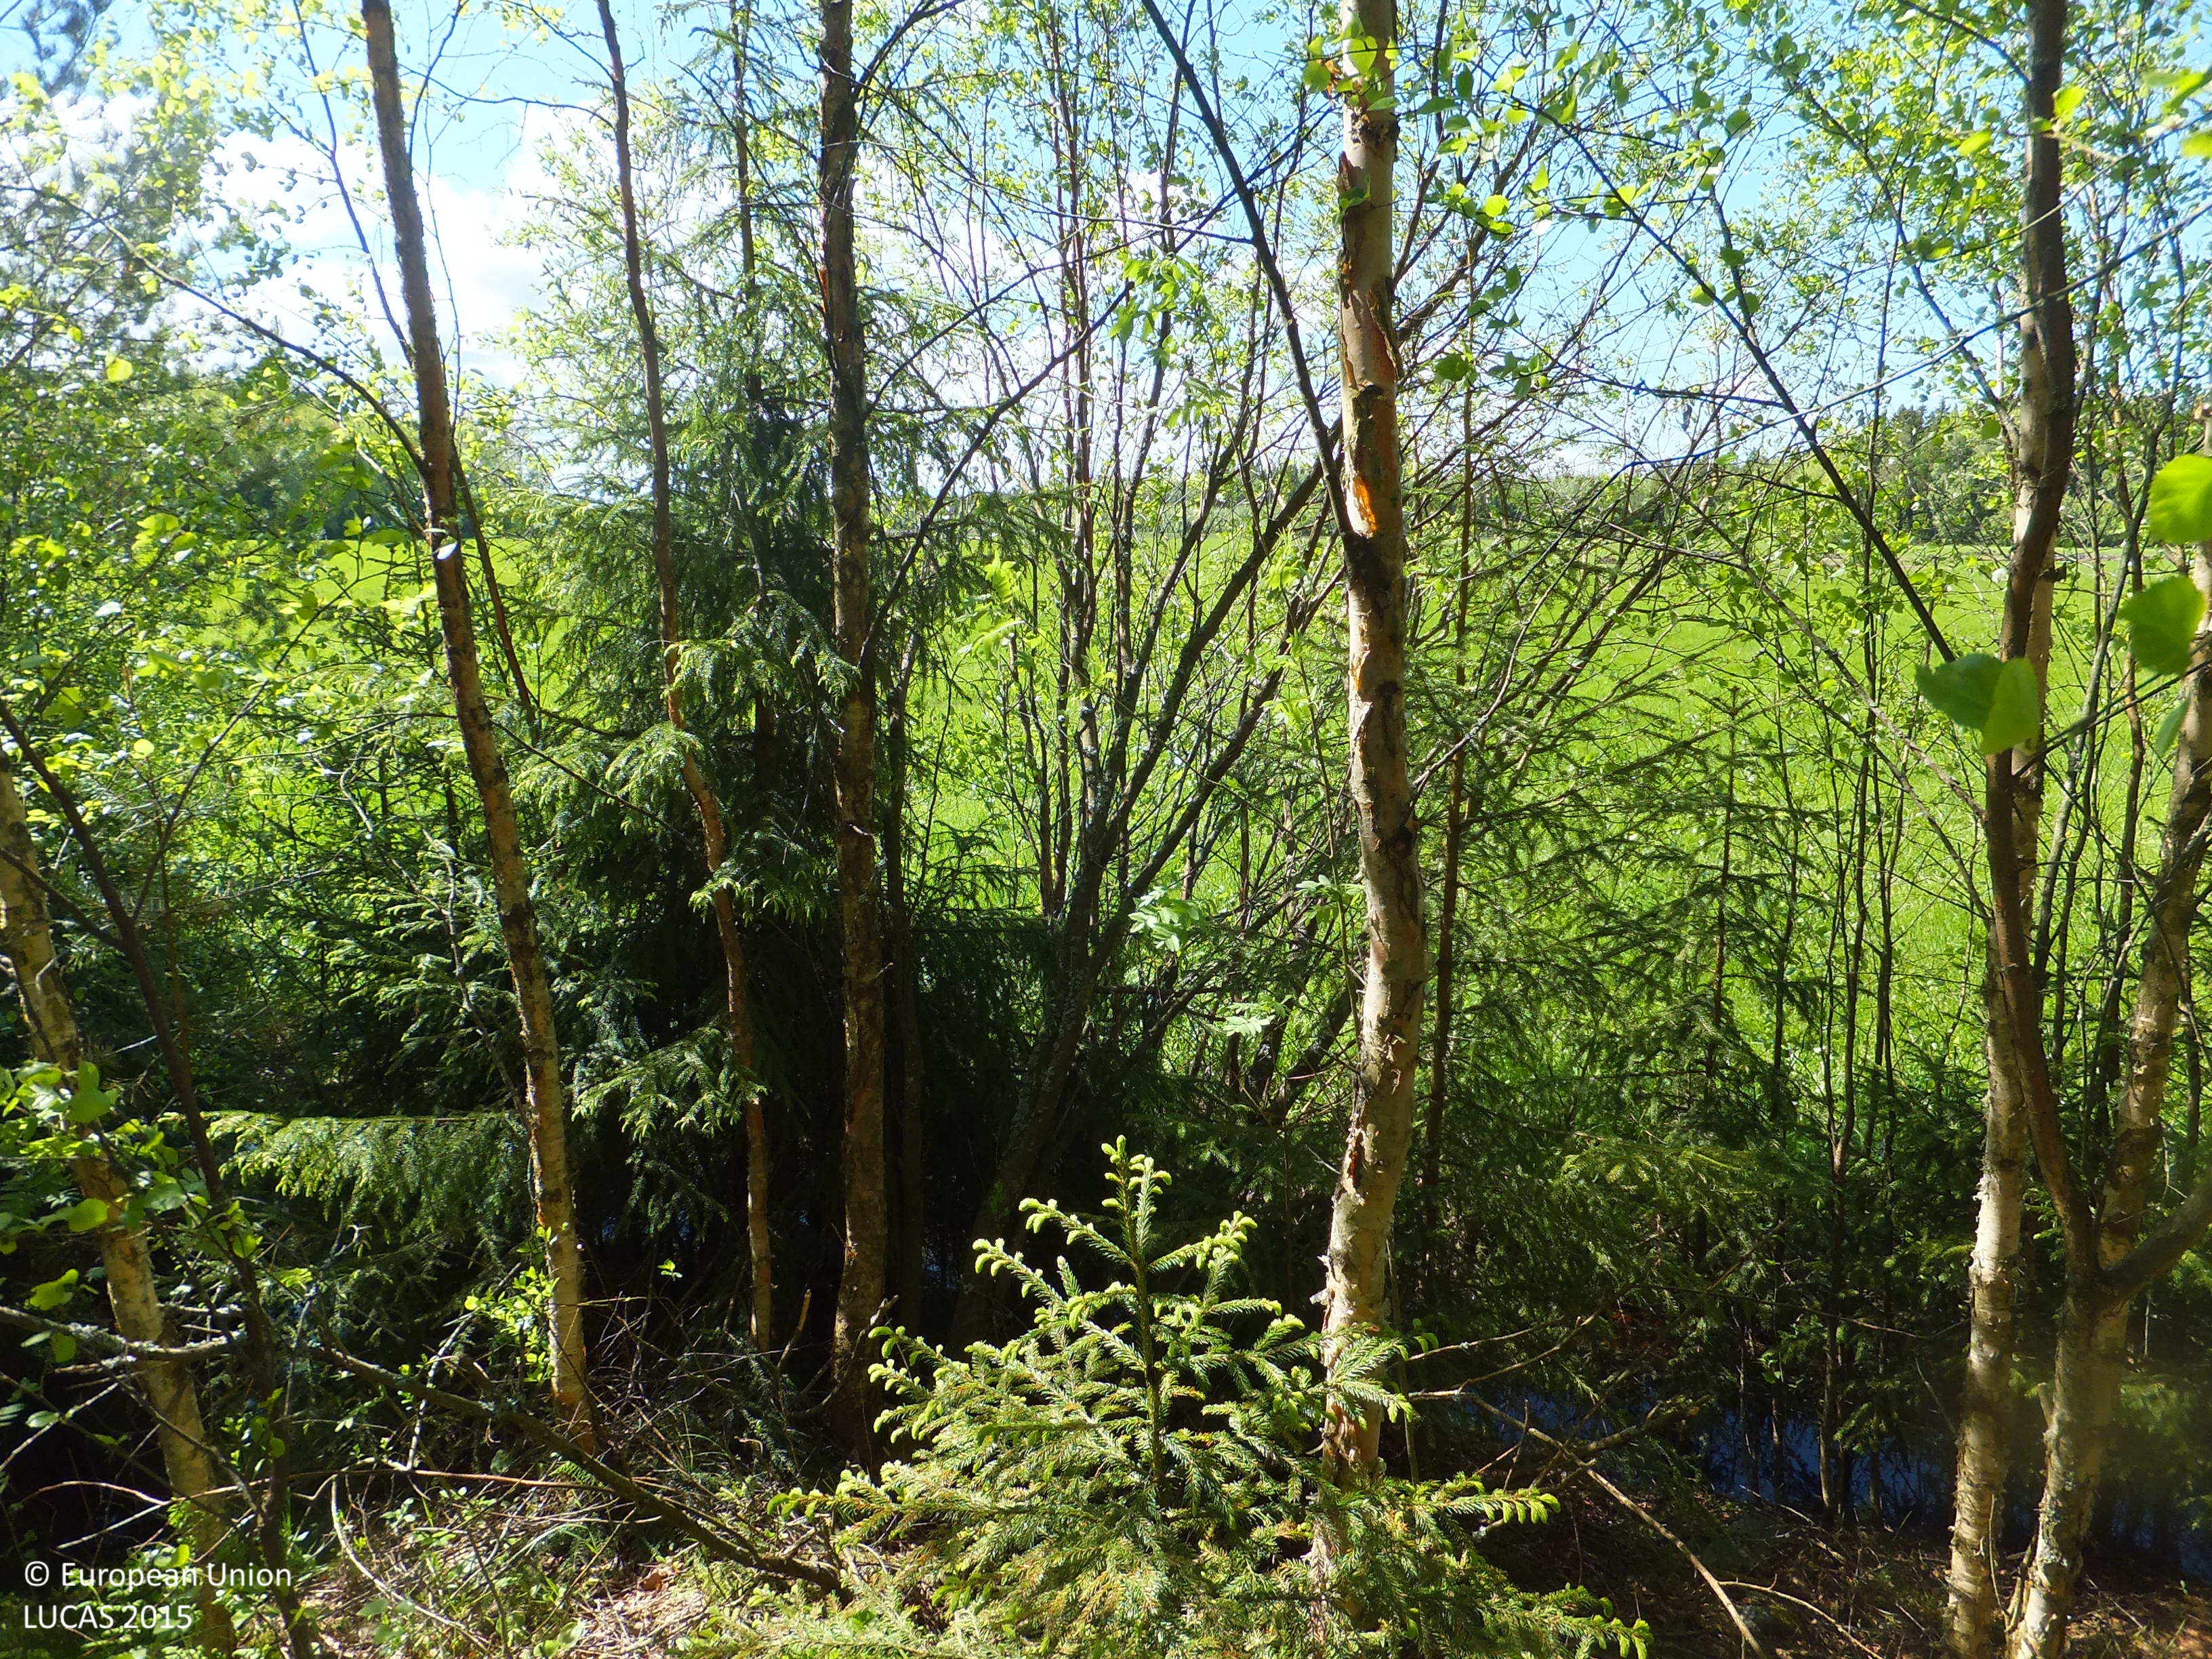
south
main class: Woodland
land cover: Spruce dominated mixed woodland
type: boreal forest
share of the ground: 50 - 75 %
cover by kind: coniferous forest trees 30 %, broadleaved forest trees 30 %, shrubs 20 %, herbaceous plants 10 %, lichens and mosses 10 %
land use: Forestry
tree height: > 5 m
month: June
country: FI
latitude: 63.6445
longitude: 22.9535
